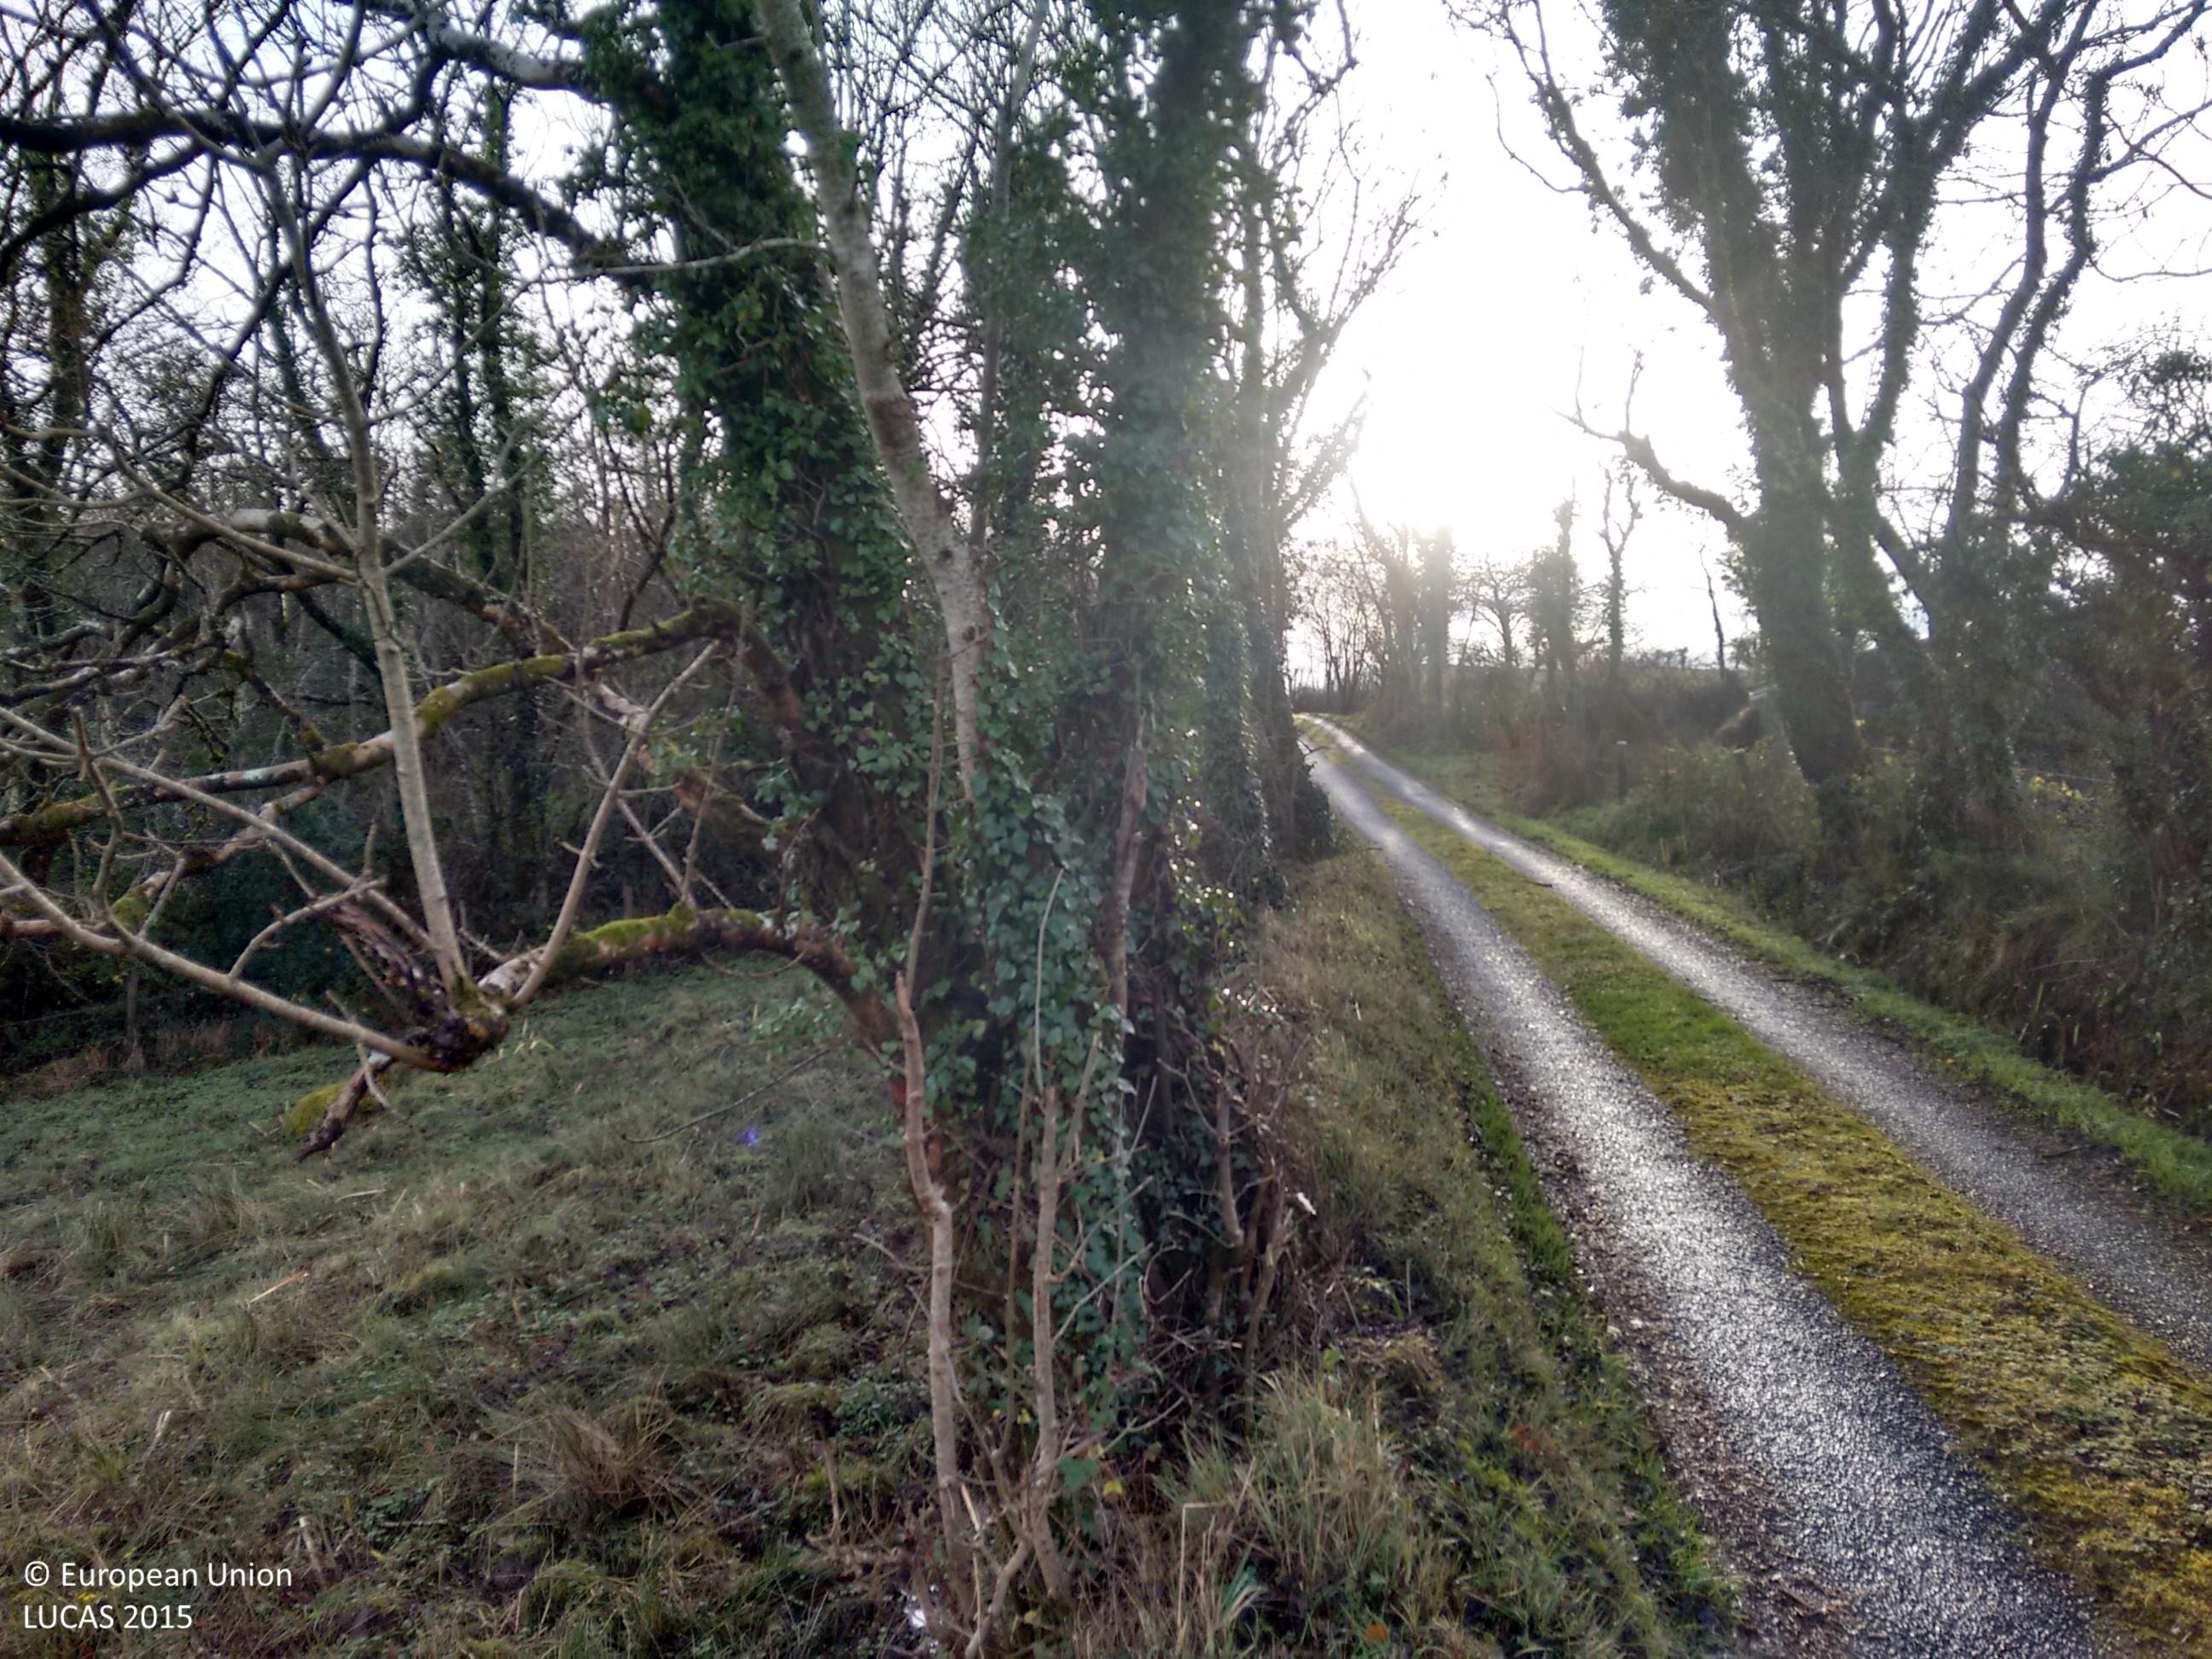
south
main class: Woodland
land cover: Broadleaved woodland
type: exotic forest
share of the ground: > 75 %
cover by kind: broadleaved forest trees 95 %, coniferous forest trees 5 %
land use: Forestry
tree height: > 5 m
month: November
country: IE
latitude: 54.2386
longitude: -8.2098
